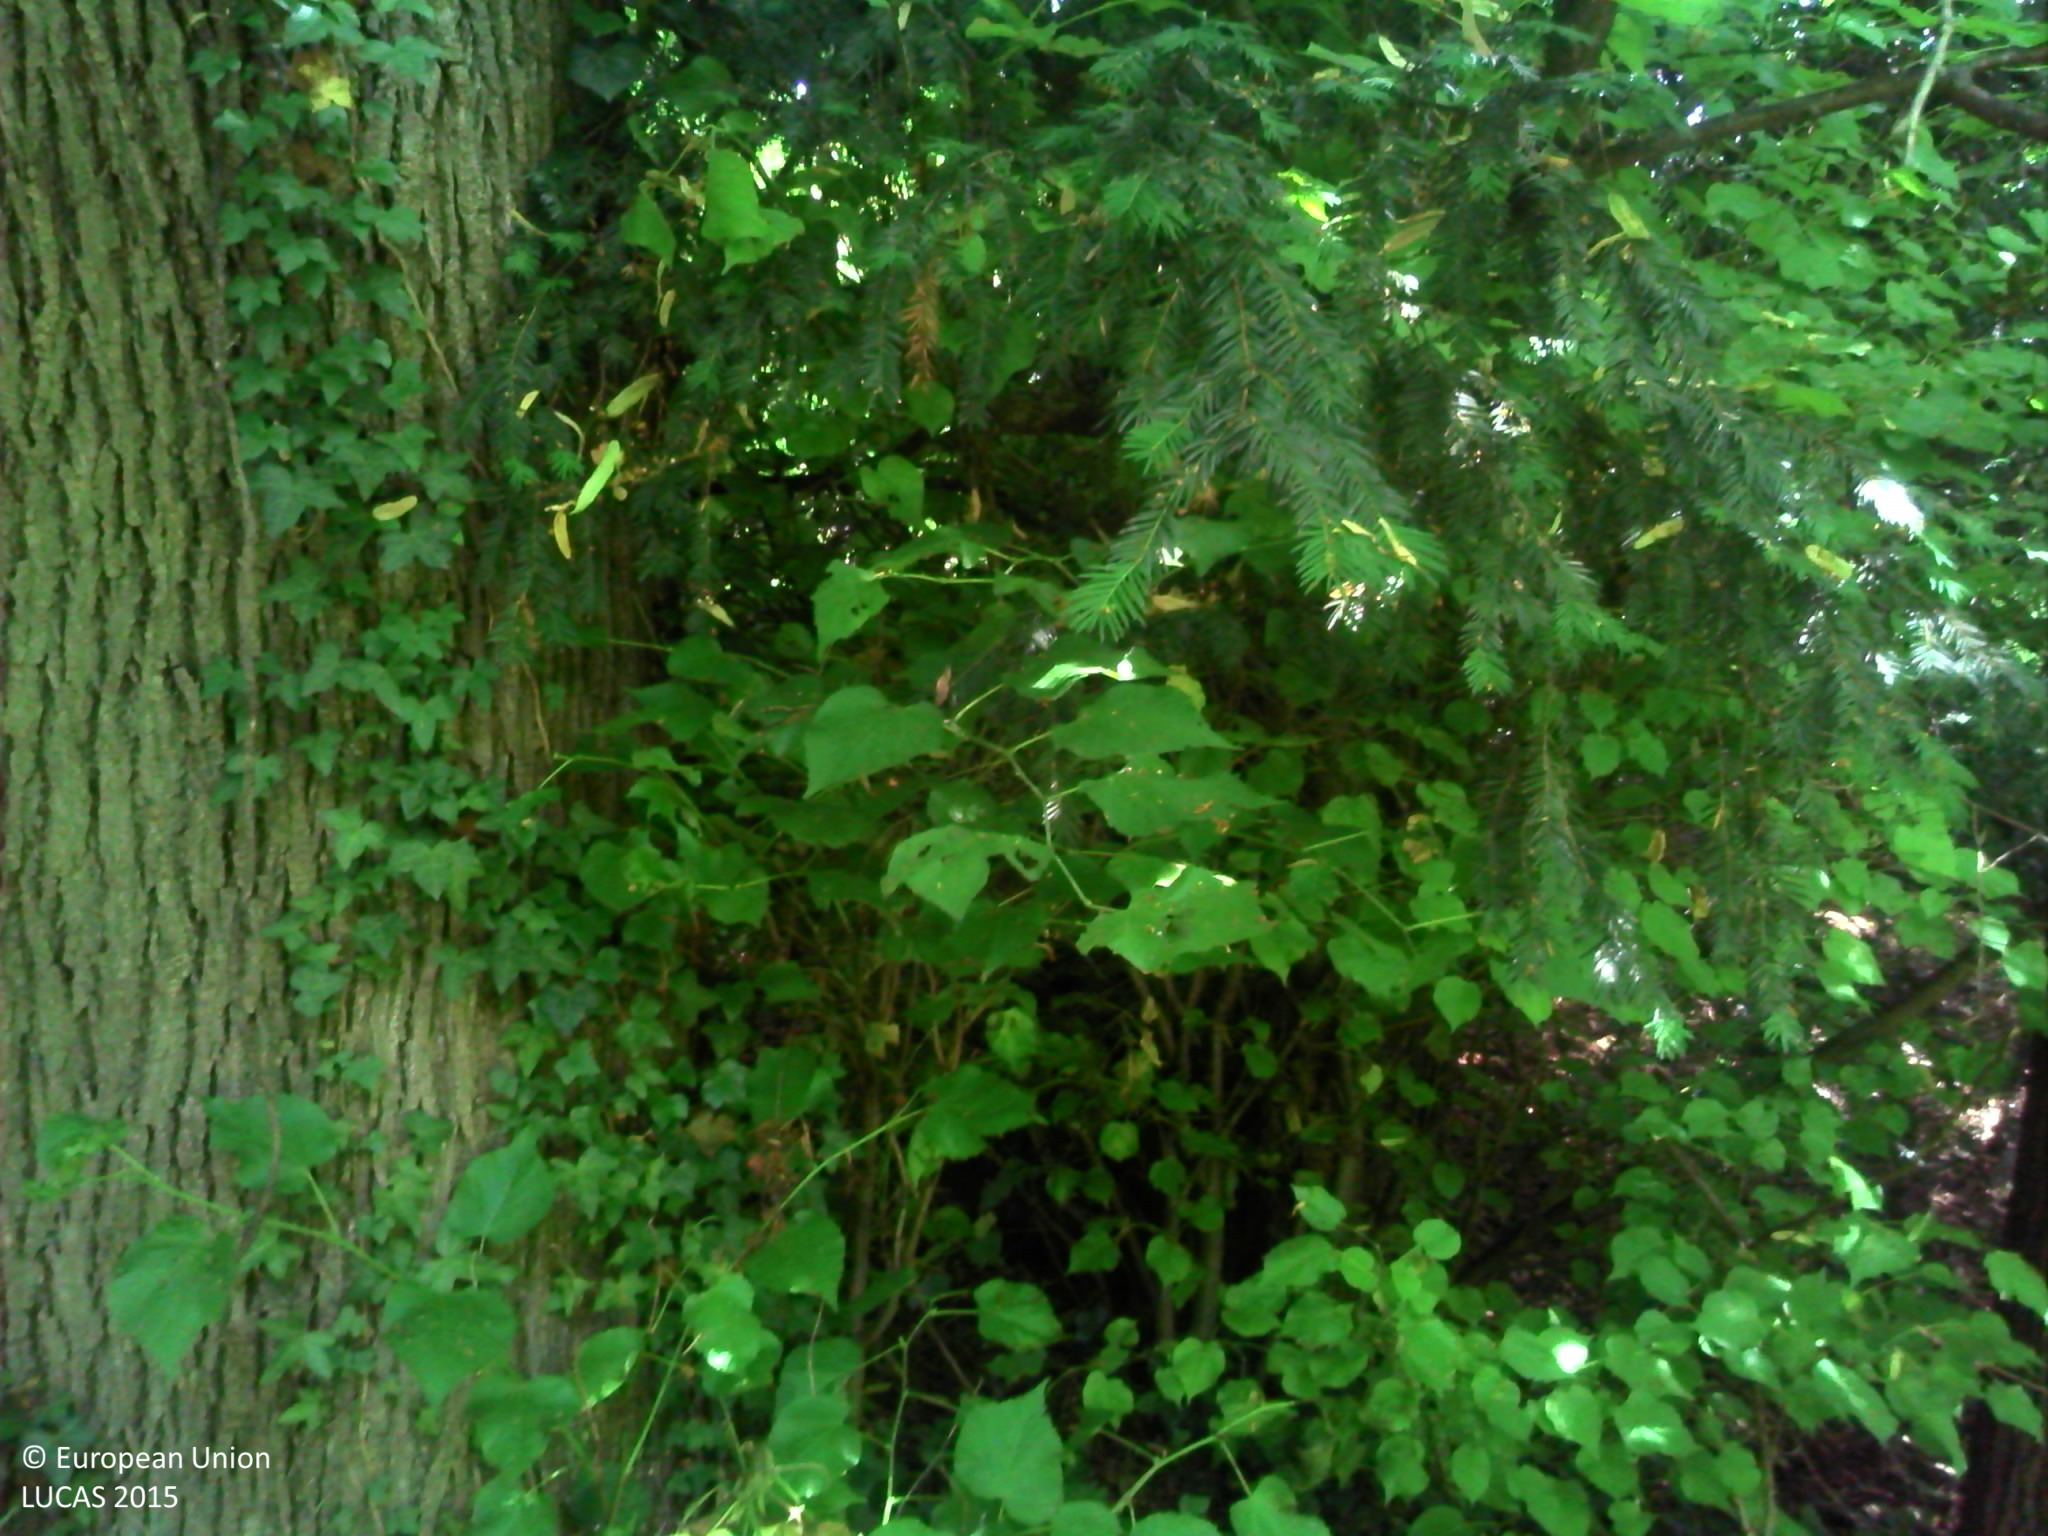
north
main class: Woodland
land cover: Spruce dominated mixed woodland
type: mesophytic deciduous forest
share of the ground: > 75 %
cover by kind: broadleaved forest trees 40 %, coniferous forest trees 30 %, herbaceous plants 25 %, unconsolidated bare surface 5 %
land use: Amenities, museums, leisure
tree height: > 5 m
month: July
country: FR
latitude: 45.6947
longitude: 3.1039
